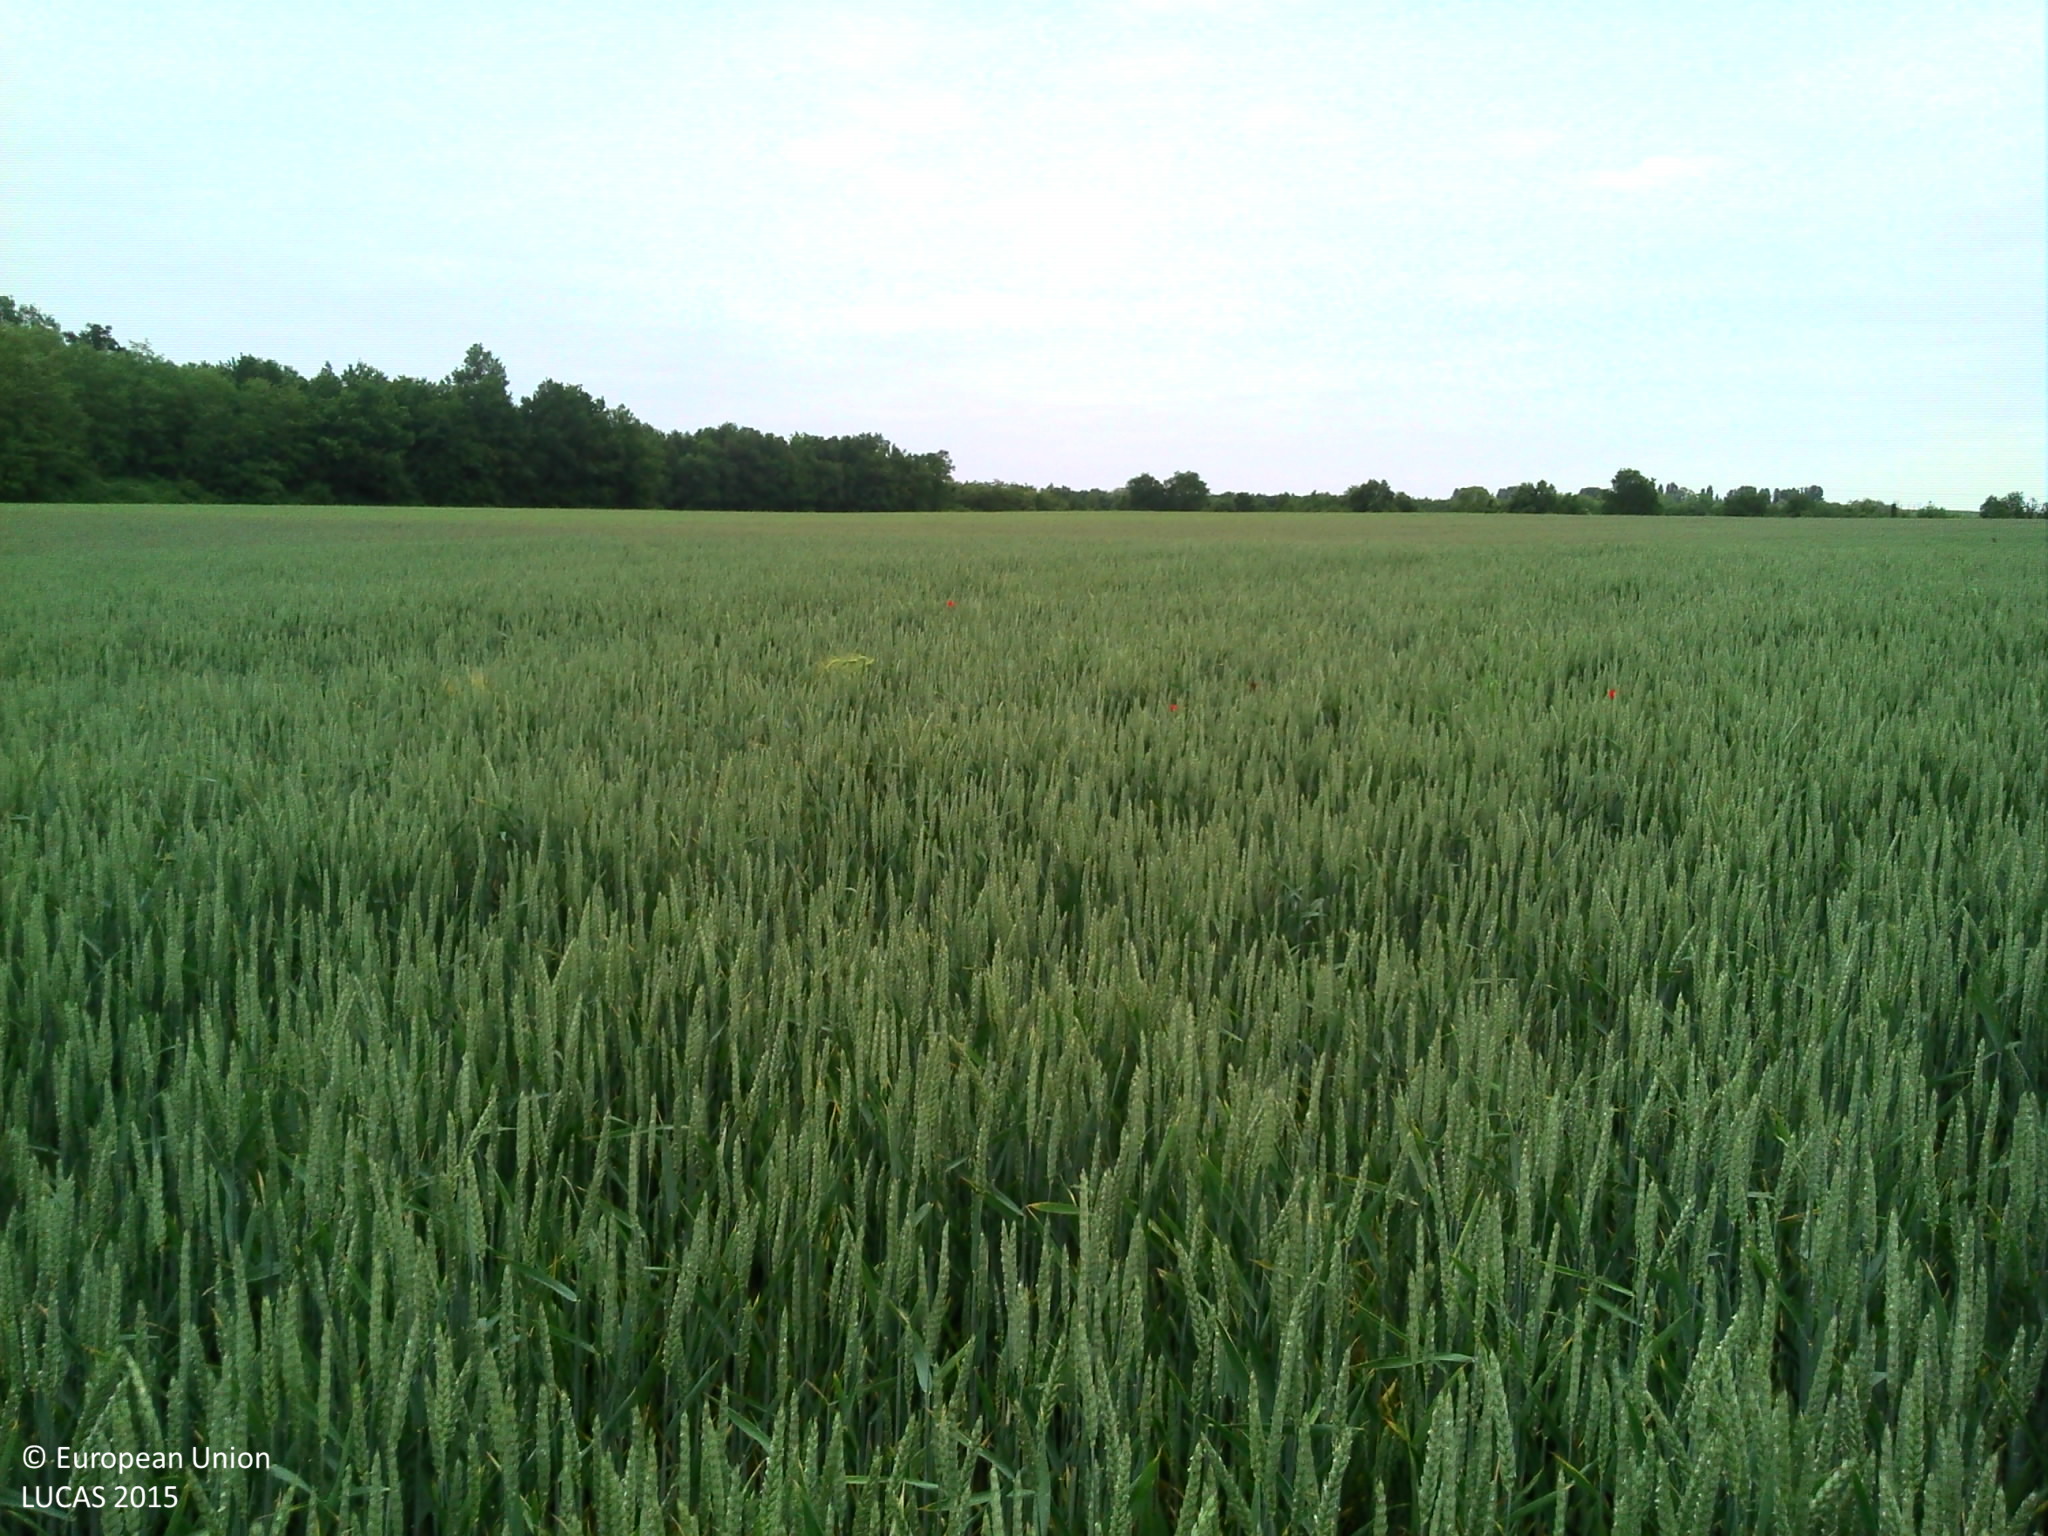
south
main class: Cropland
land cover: Common wheat
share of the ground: > 75 %
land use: Agriculture (excluding fallow land and kitchen gardens)
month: May
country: FR
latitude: 46.7371
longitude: 0.2293
